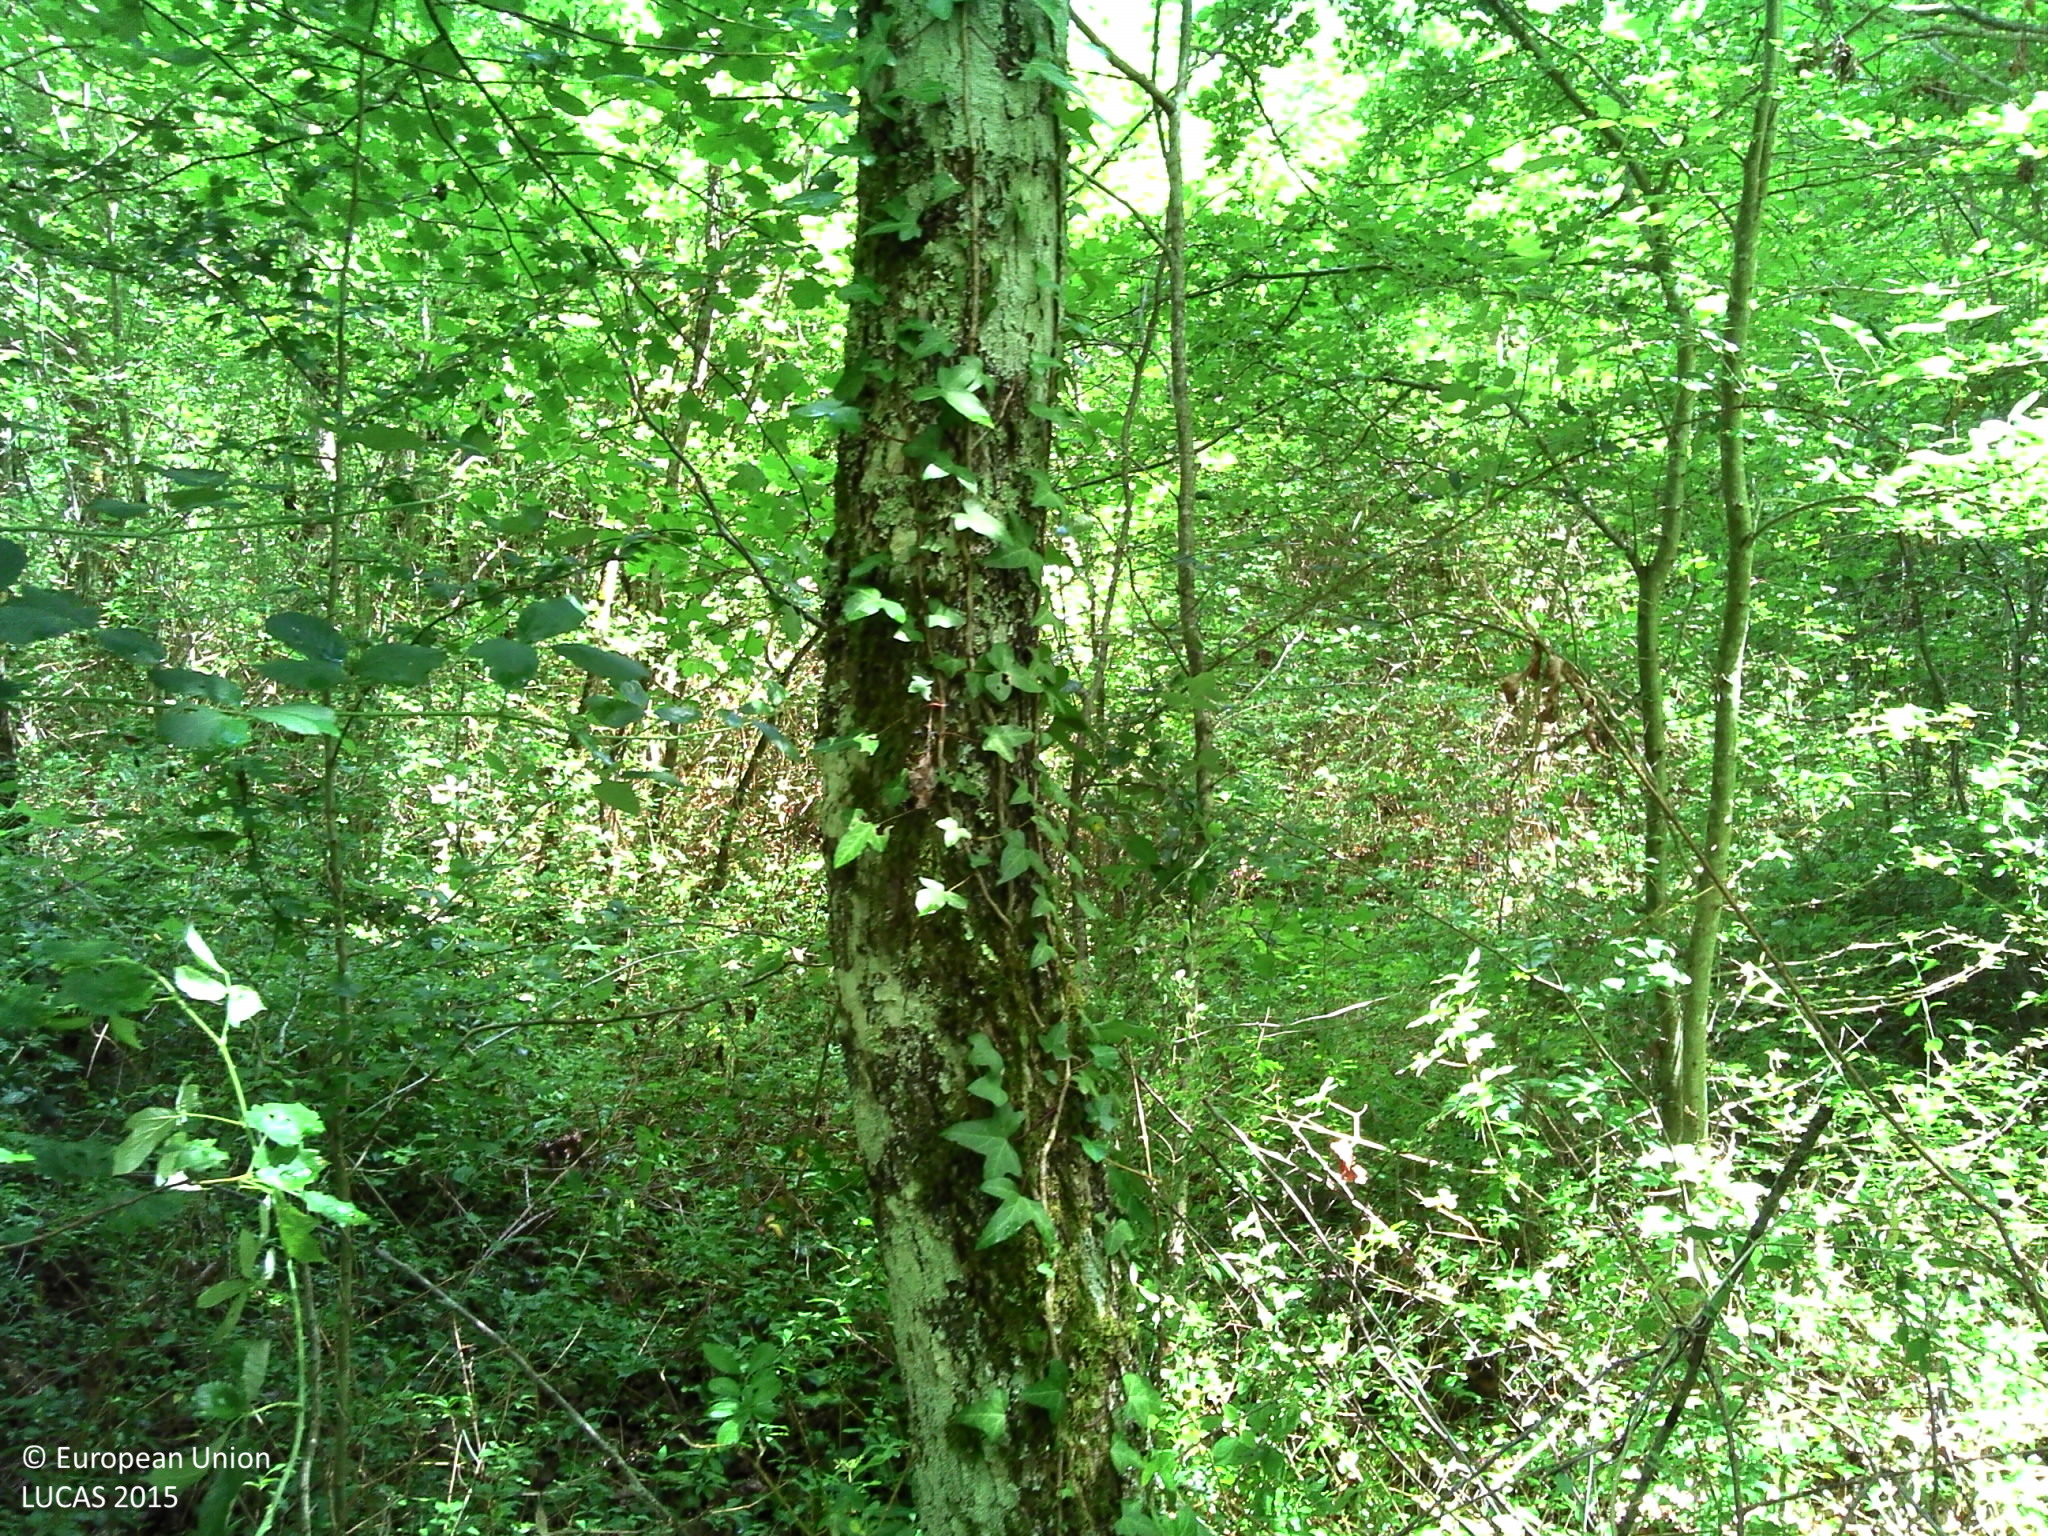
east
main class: Woodland
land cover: Broadleaved woodland
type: acidophilous oak and oak-birch forest
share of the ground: > 75 %
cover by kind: broadleaved forest trees 75 %, herbaceous plants 15 %, shrubs 5 %, lichens and mosses 5 %
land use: Forestry
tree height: > 5 m
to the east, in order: Broadleaved woodland; Fences; Tracks; Fences; Broadleaved woodland
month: June
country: FR
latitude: 44.2867
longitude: 1.8933
